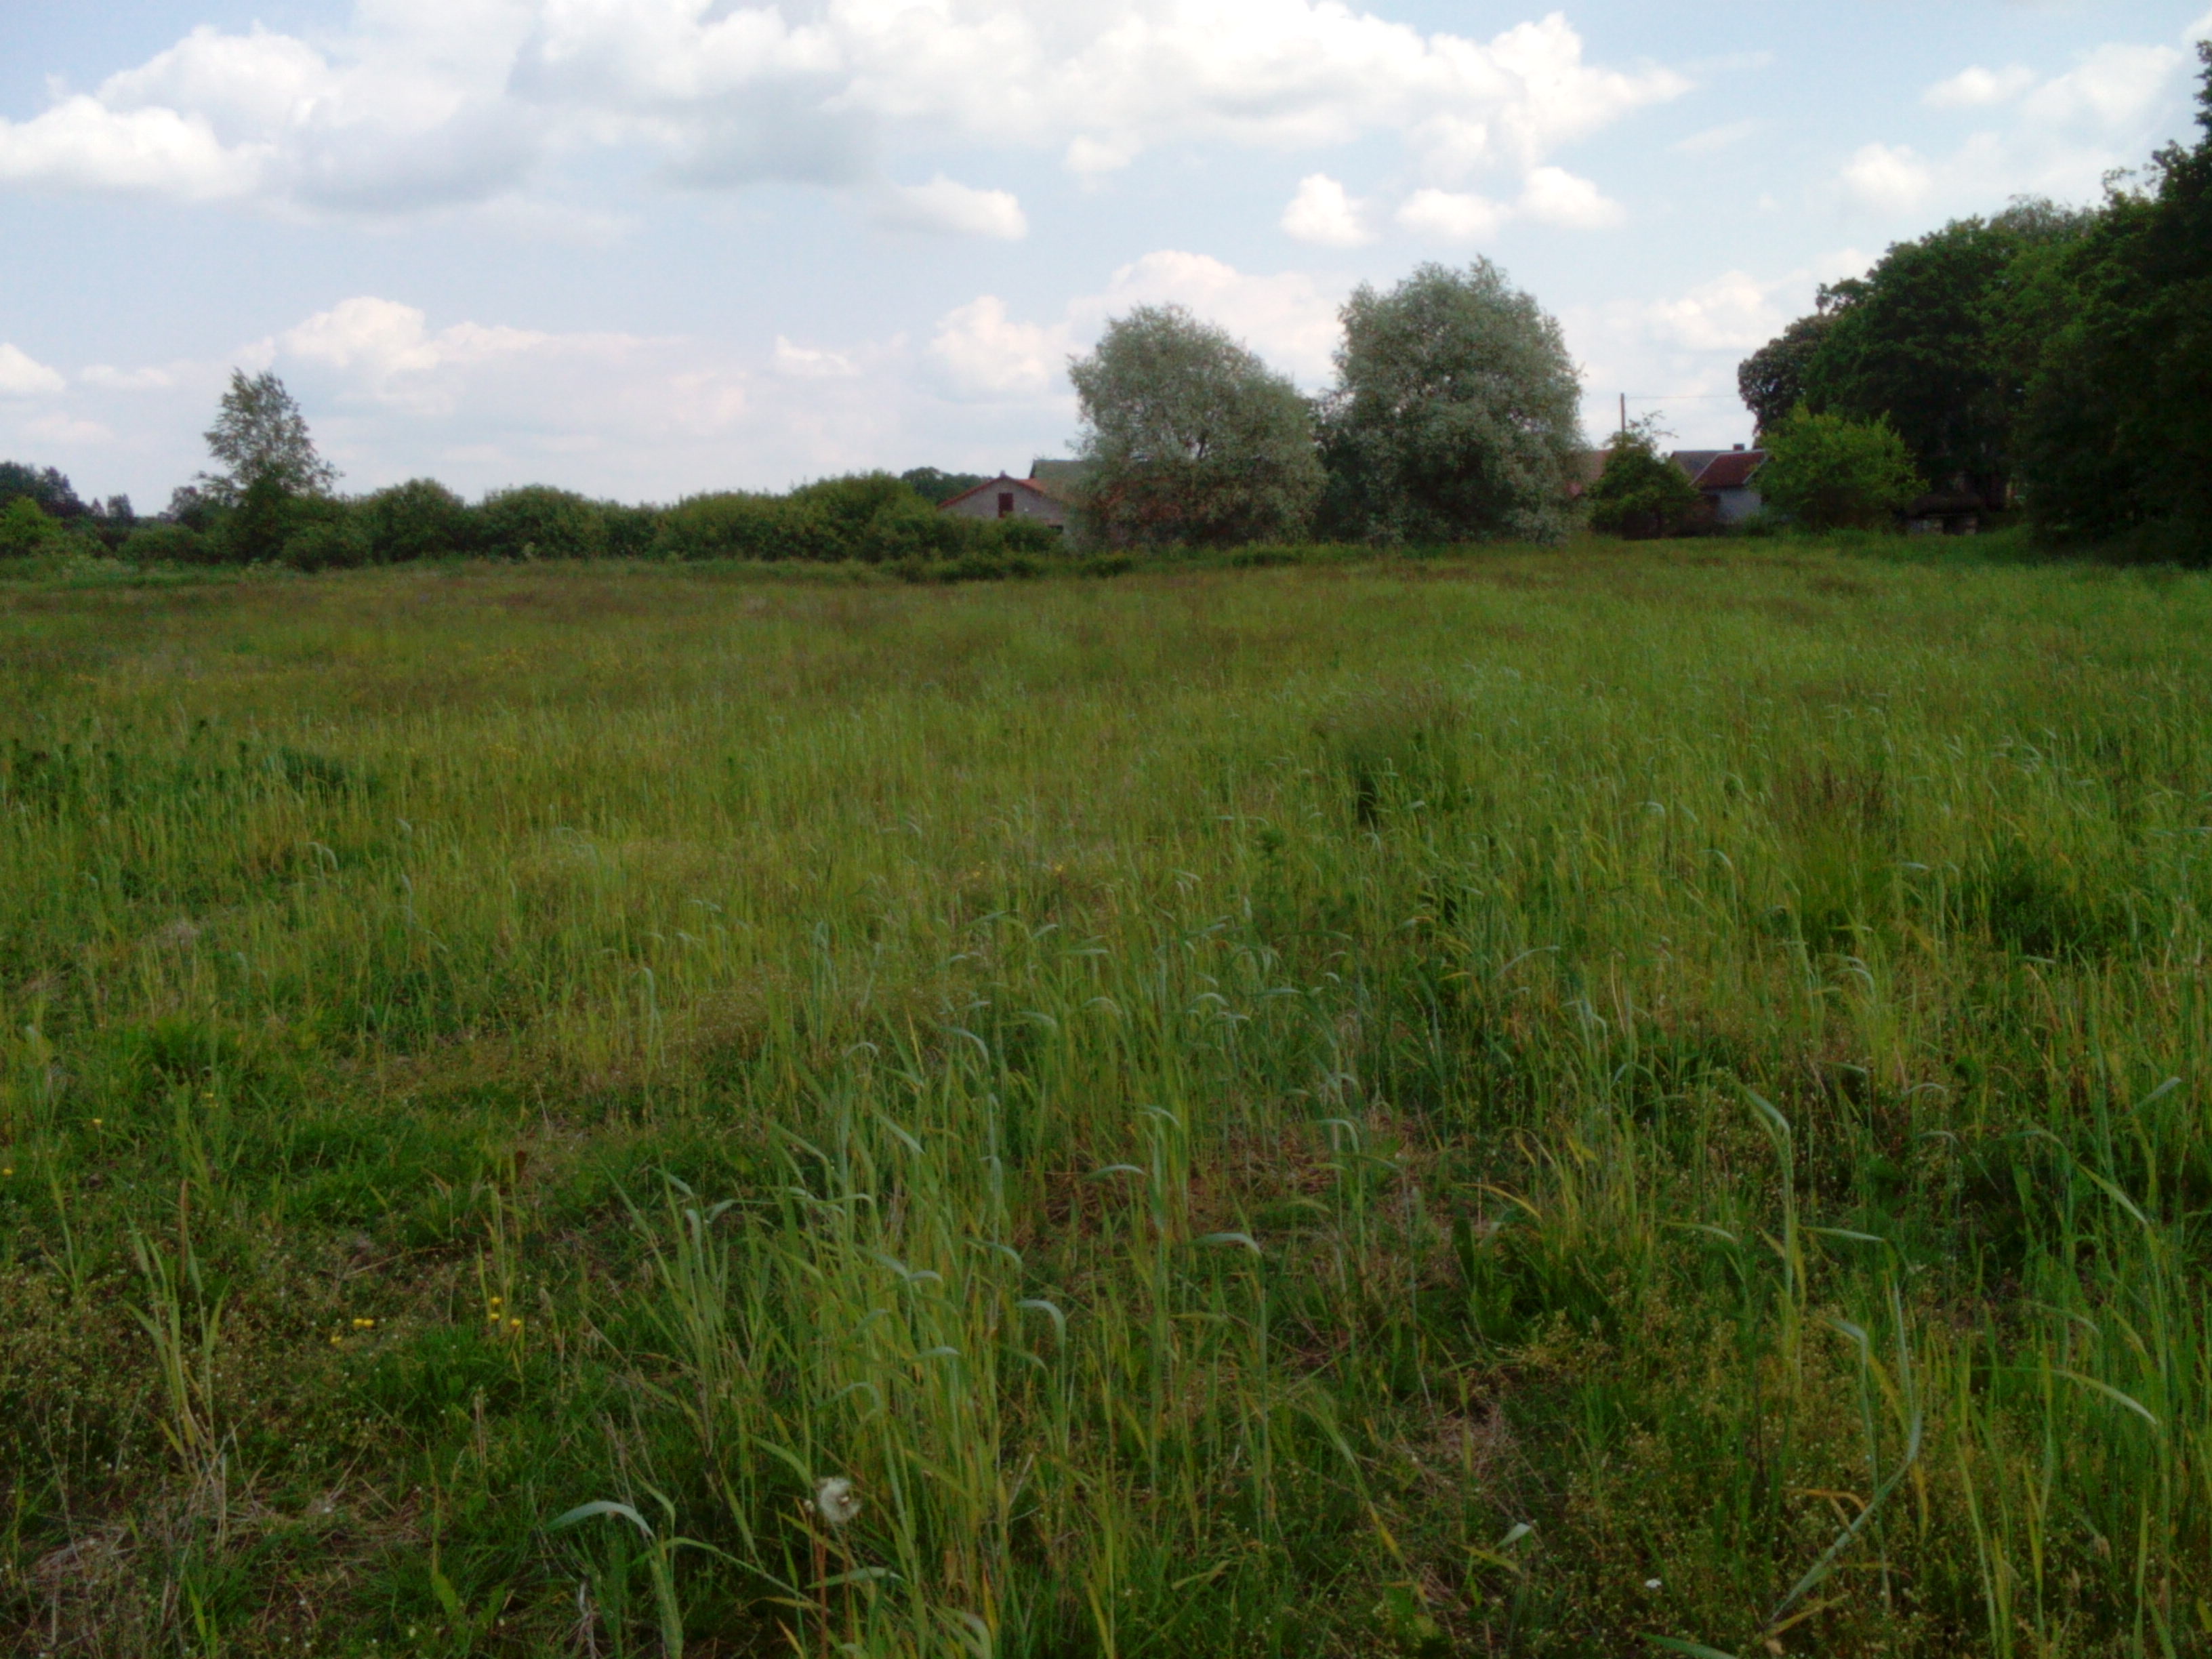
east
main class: Grassland
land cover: Grassland without tree/shrub cover
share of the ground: > 75 %
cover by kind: herbaceous plants 100 %
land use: Agriculture (excluding fallow land and kitchen gardens)
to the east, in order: Grassland without tree/shrub cover; Shruby margins; Tracks; Shruby margins; Shrubland with sparse tree cover; Grassland without tree/shrub cover
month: June
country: LV
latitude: 56.8146
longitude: 22.2894
